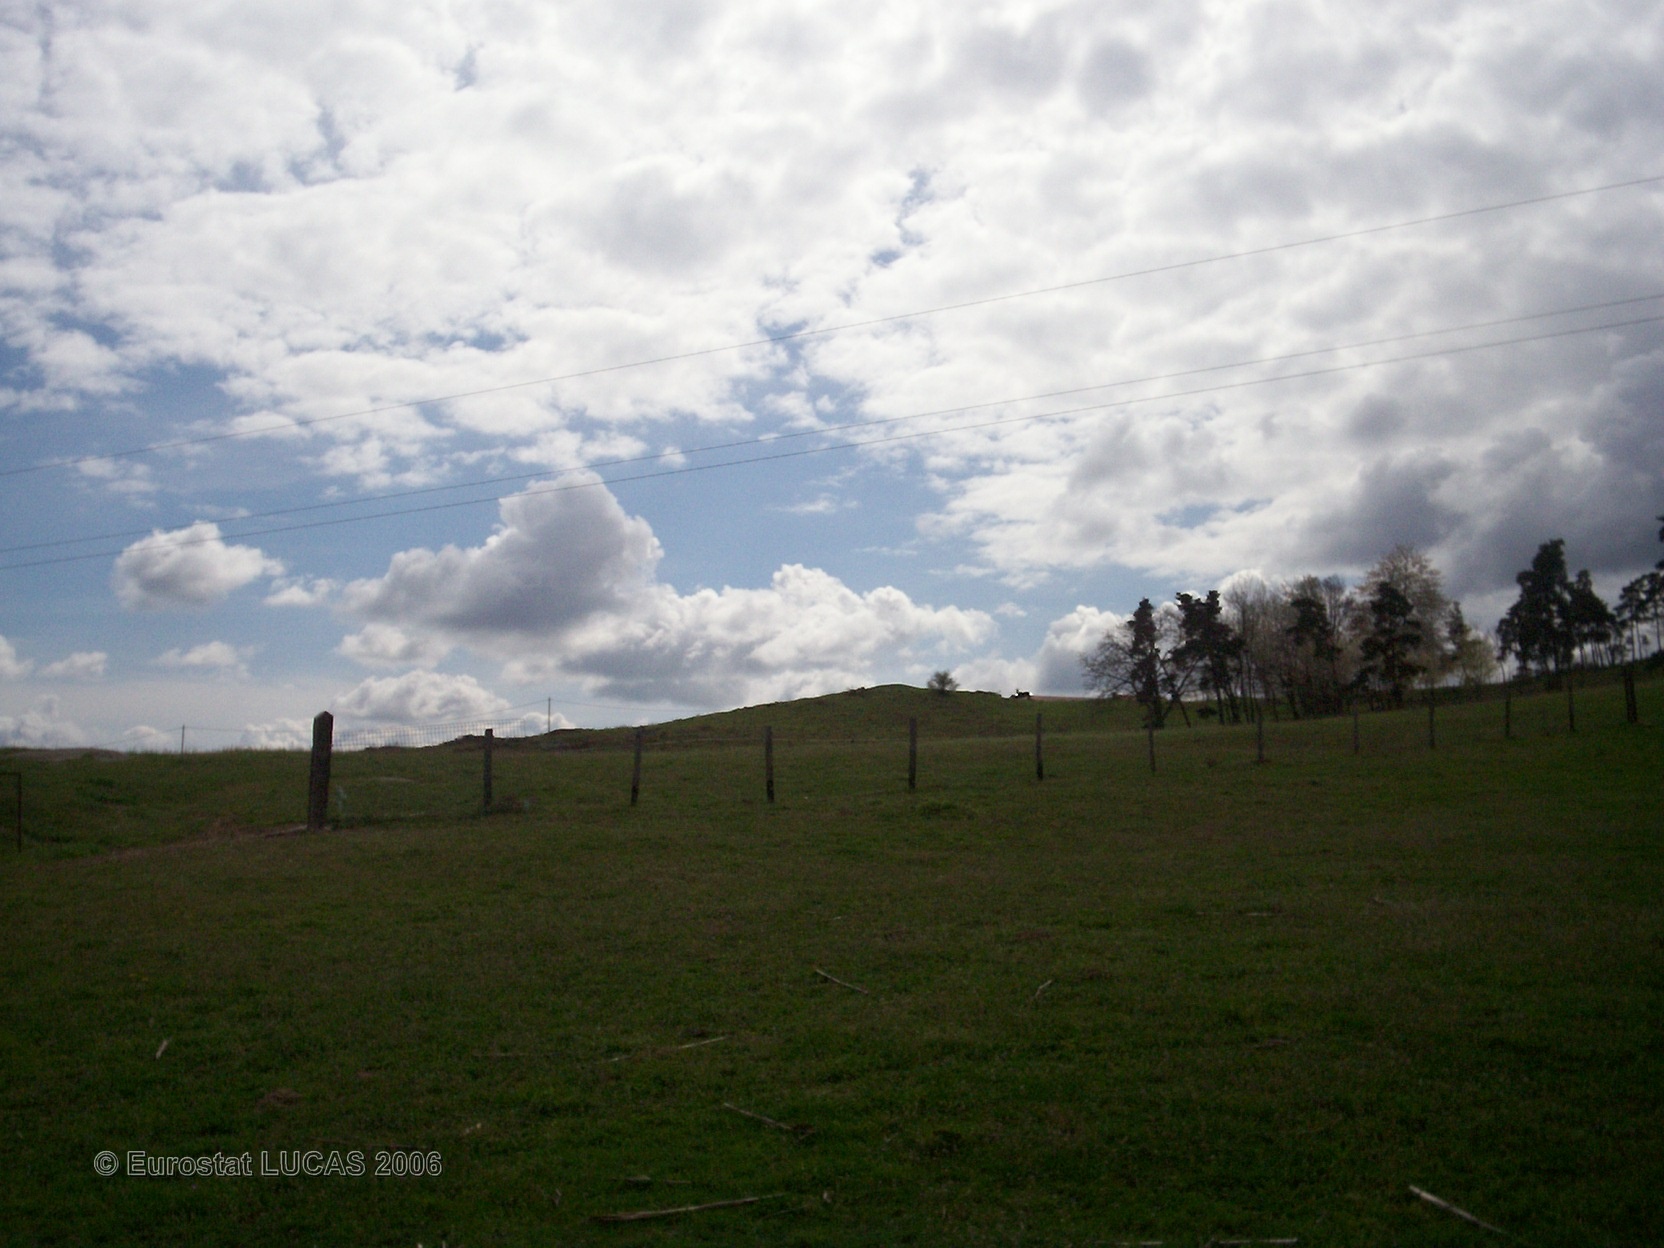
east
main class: Grassland
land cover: Grassland without tree/shrub cover
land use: Agriculture (excluding fallow land and kitchen gardens)
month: April
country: FR
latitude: 45.4719
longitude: 4.2090
